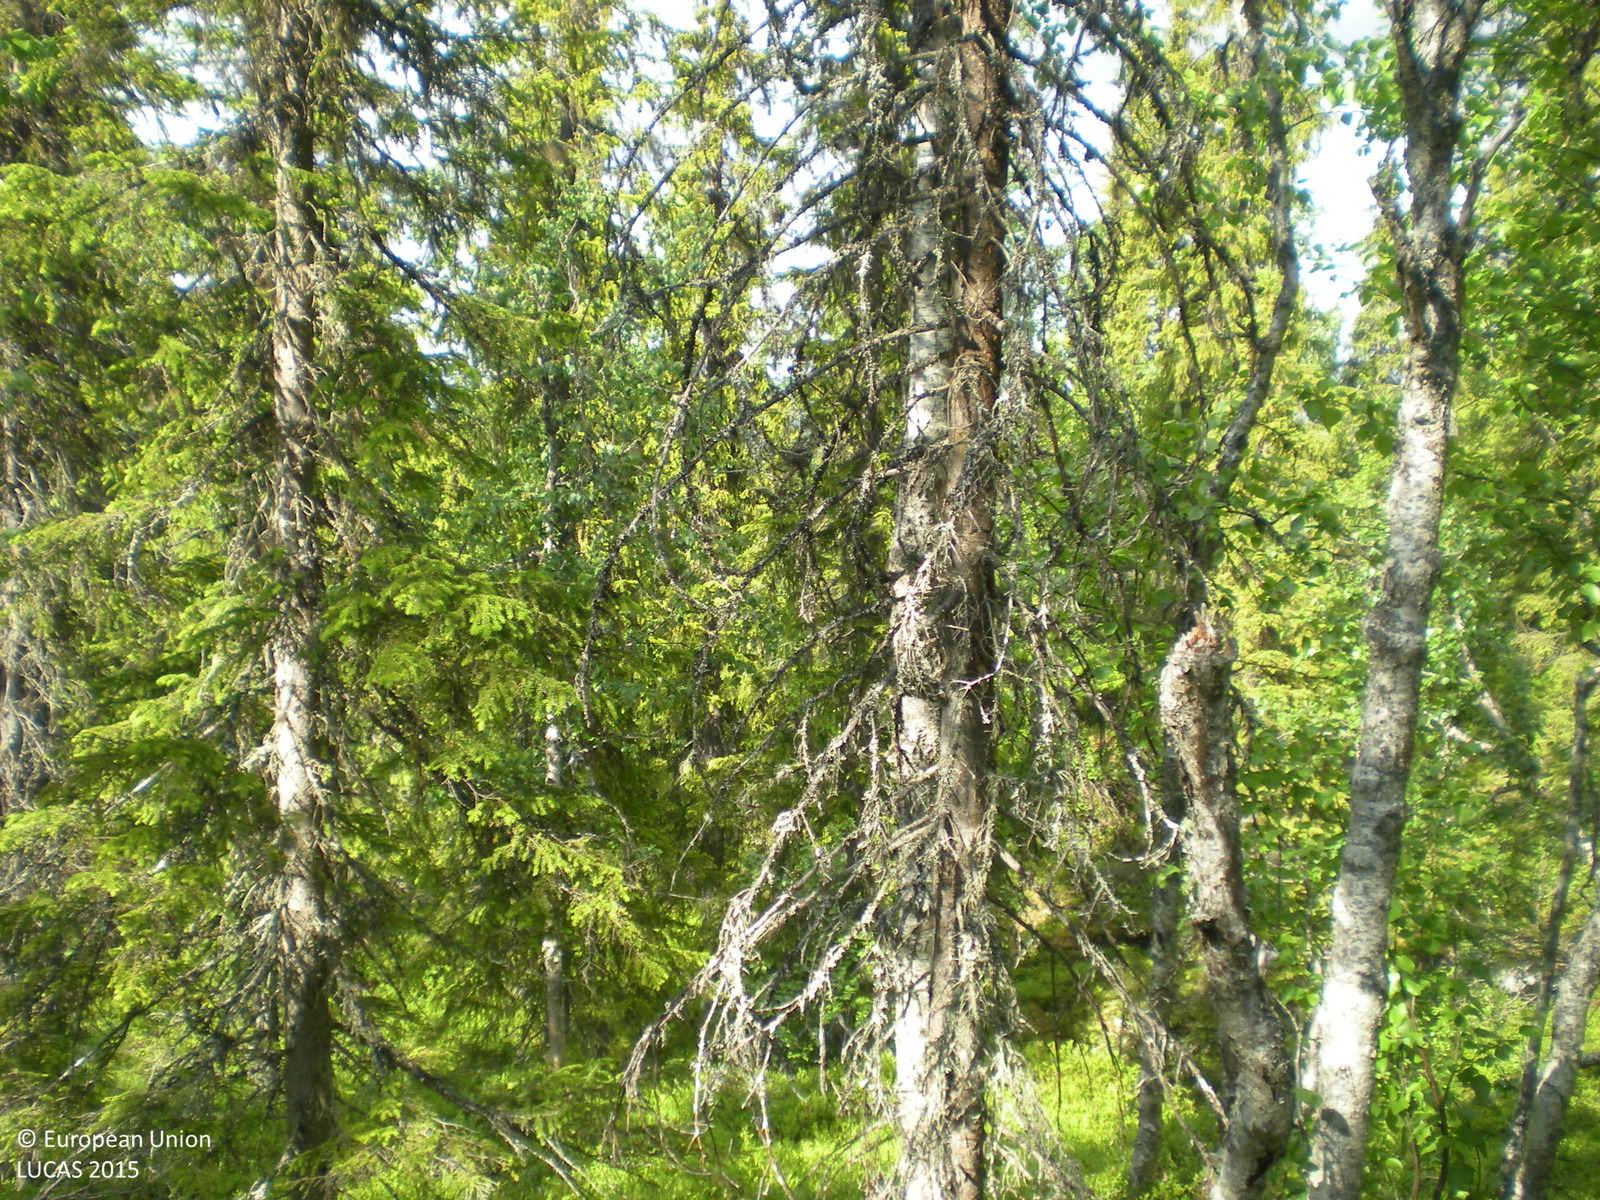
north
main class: Woodland
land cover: Spruce dominated mixed woodland
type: boreal forest
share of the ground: 50 - 75 %
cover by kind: coniferous forest trees 35 %, broadleaved forest trees 30 %, shrubs 25 %, lichens and mosses 10 %
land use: Forestry
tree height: > 5 m
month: July
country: SE
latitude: 65.5558
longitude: 16.8690
